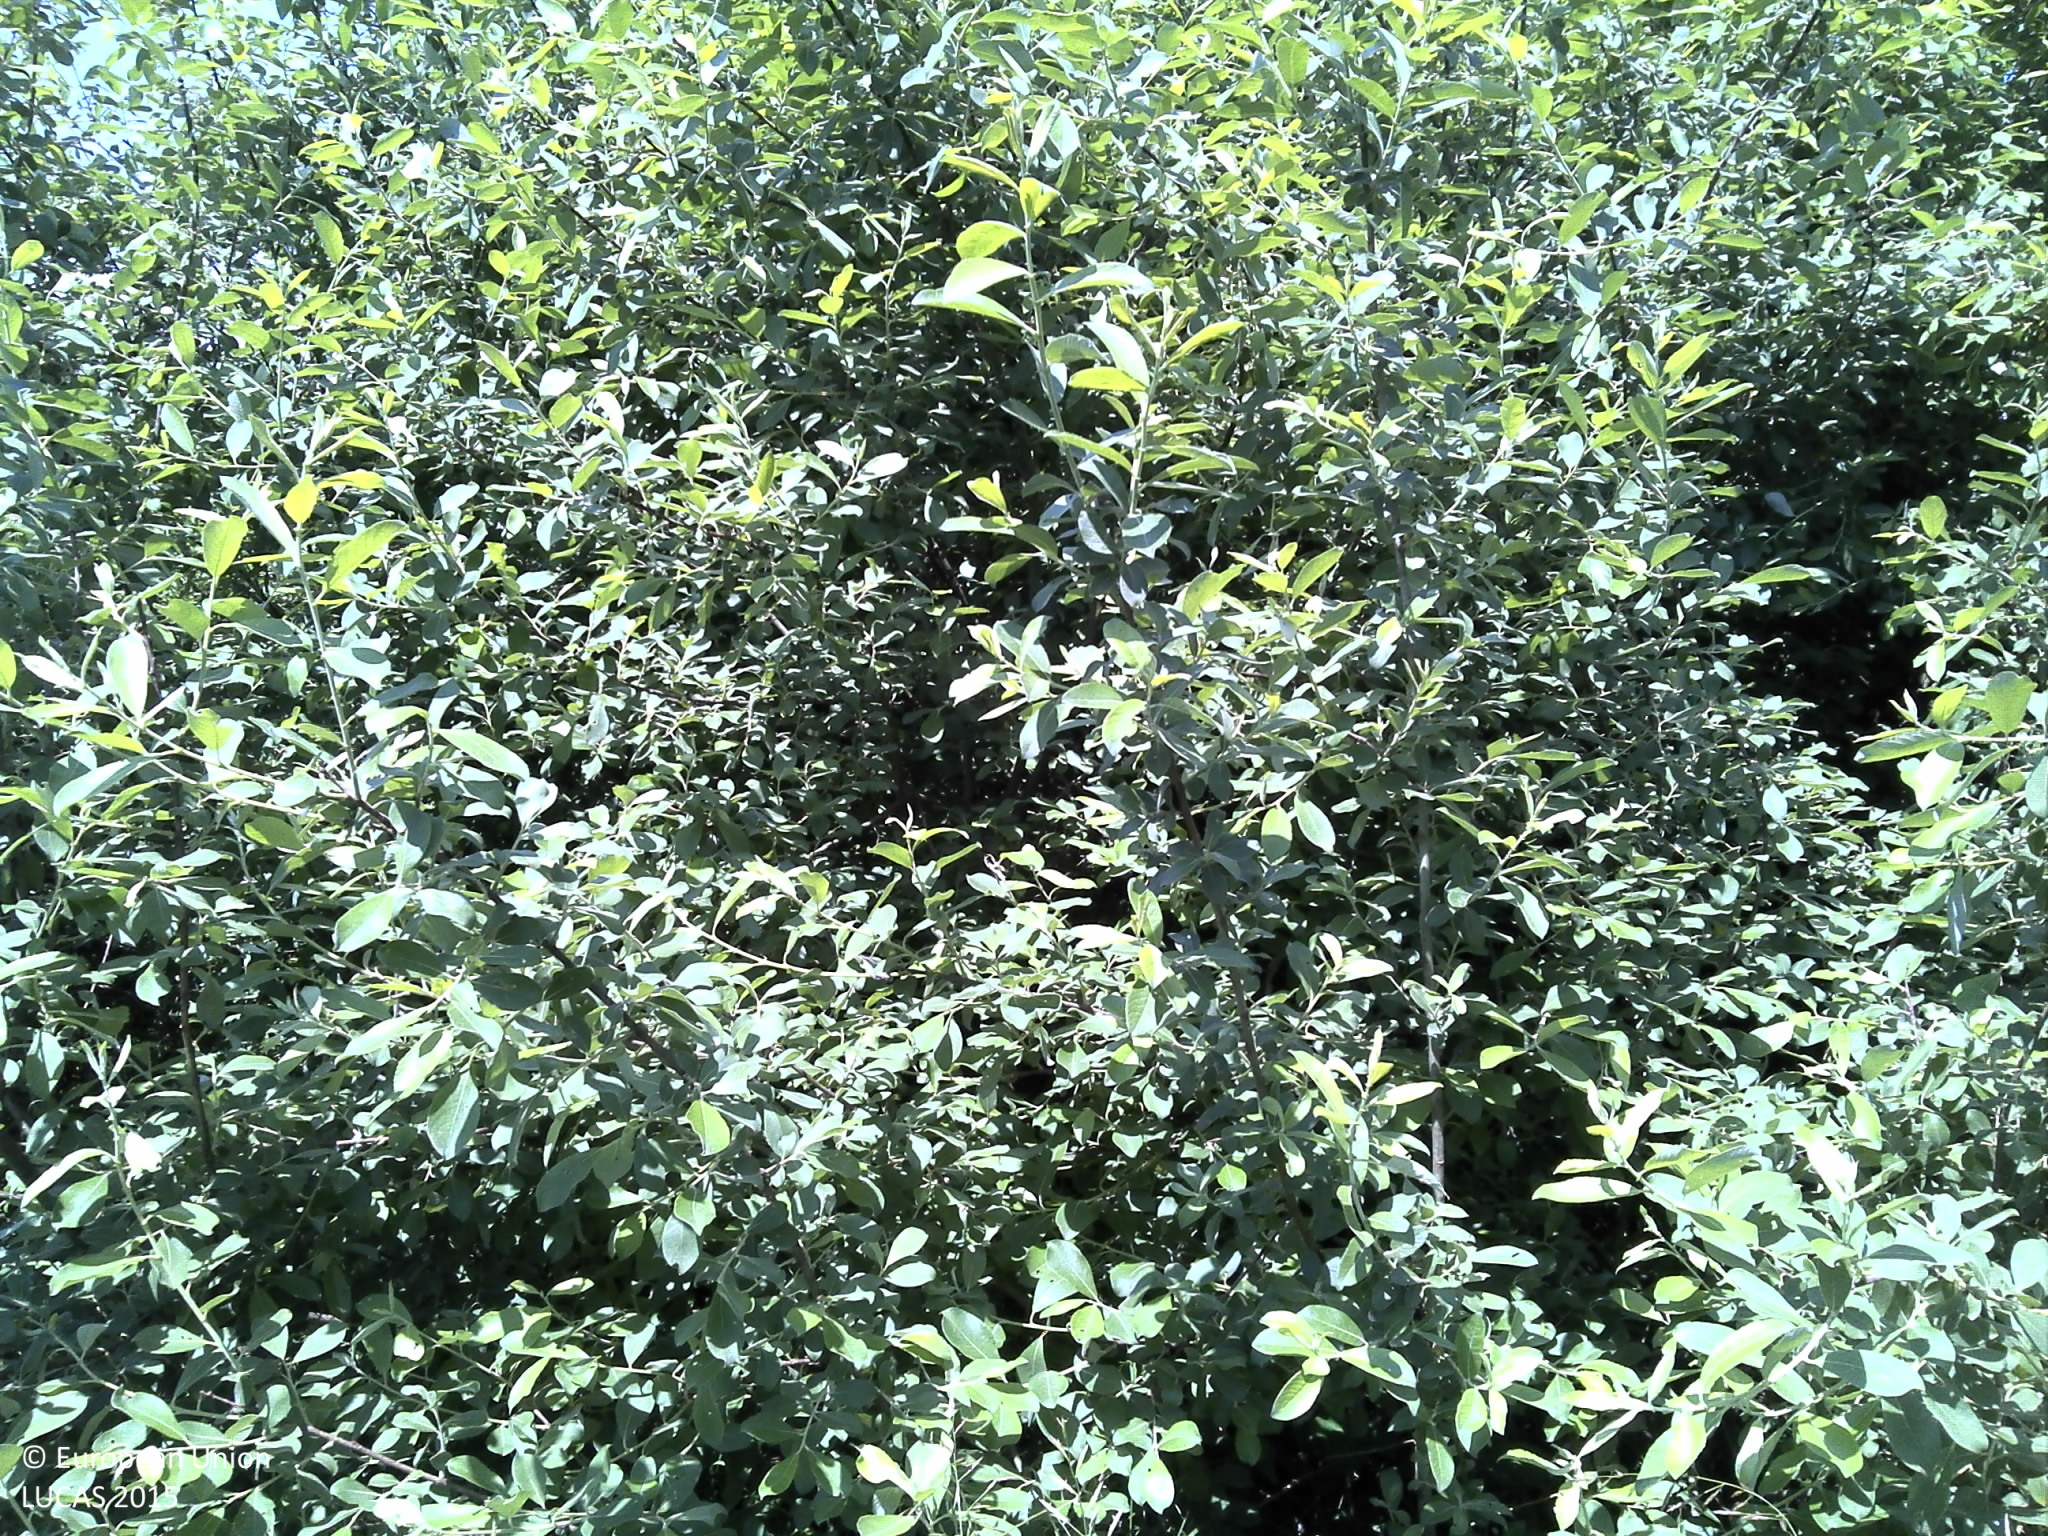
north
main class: Woodland
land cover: Broadleaved woodland
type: mesophytic deciduous forest
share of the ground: > 75 %
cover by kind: broadleaved forest trees 100 %
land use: Forestry
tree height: > 5 m
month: May
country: HR
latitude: 45.3013
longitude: 18.1015
